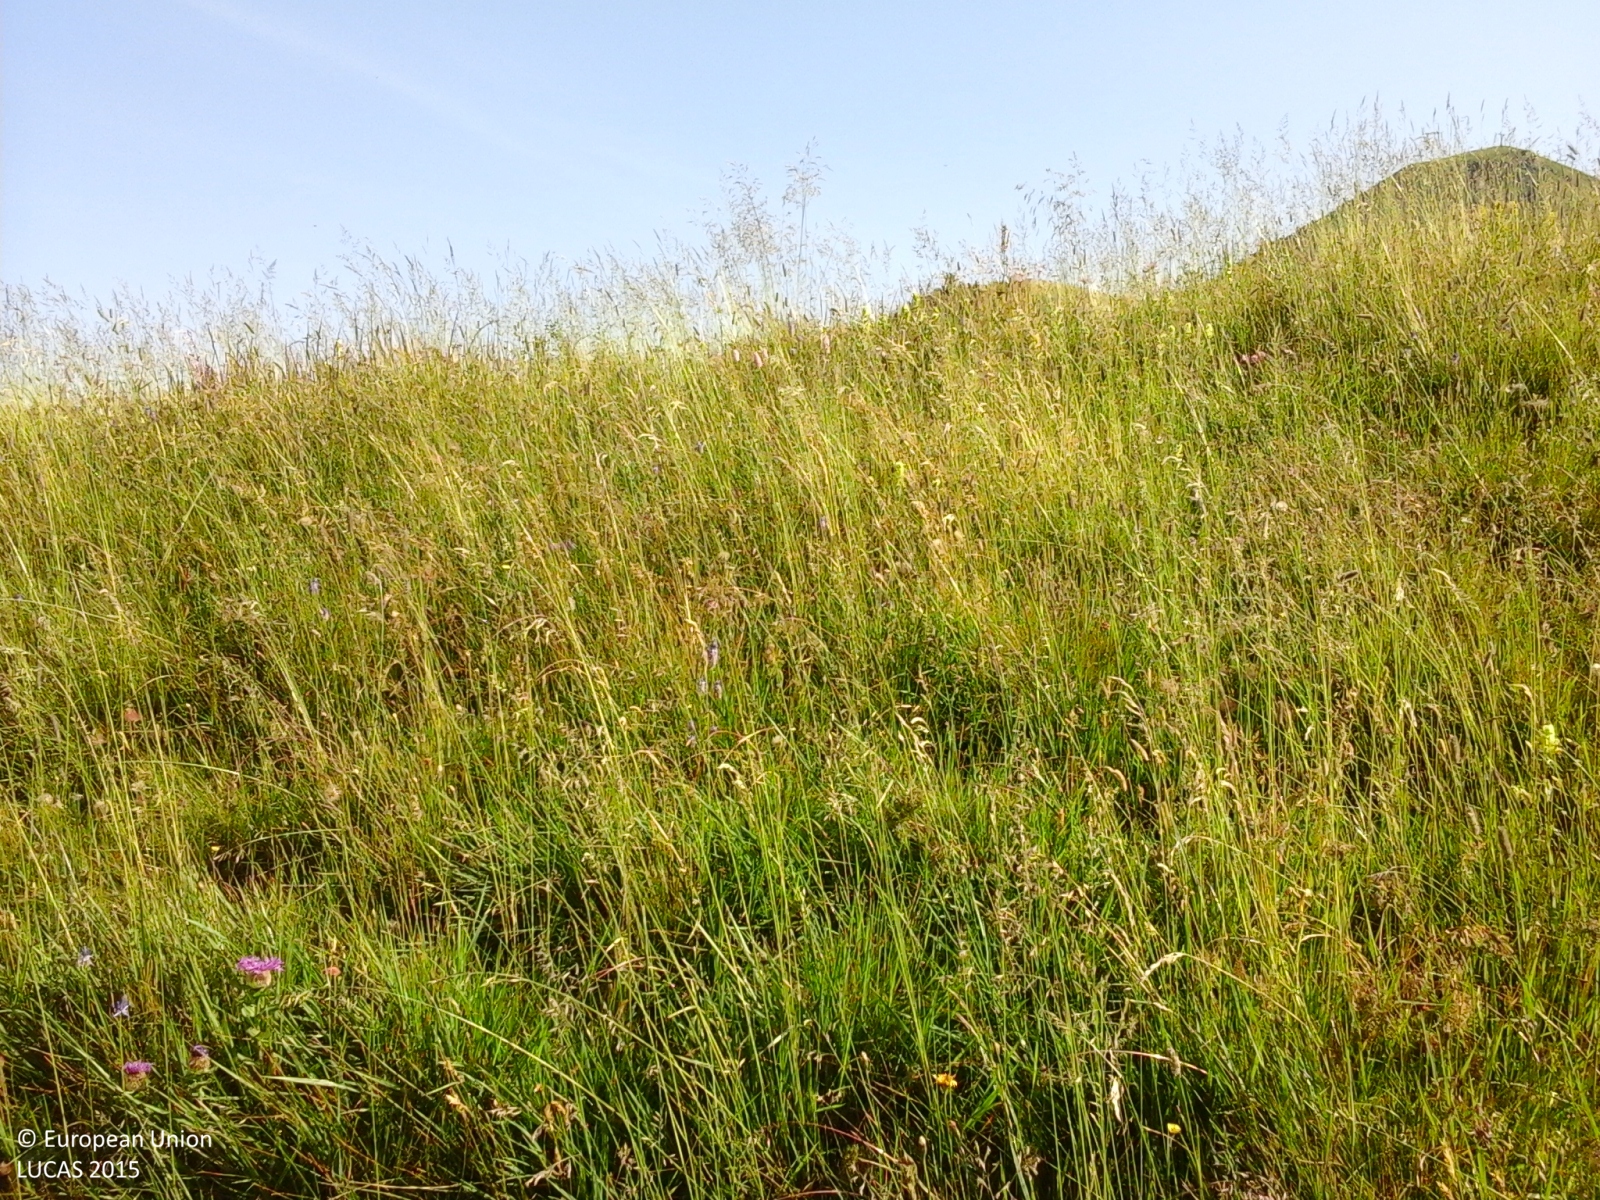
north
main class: Grassland
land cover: Grassland without tree/shrub cover
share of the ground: > 75 %
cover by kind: herbaceous plants 100 %
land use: Agriculture (excluding fallow land and kitchen gardens)
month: July
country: IT
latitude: 46.0267
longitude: 10.2451
